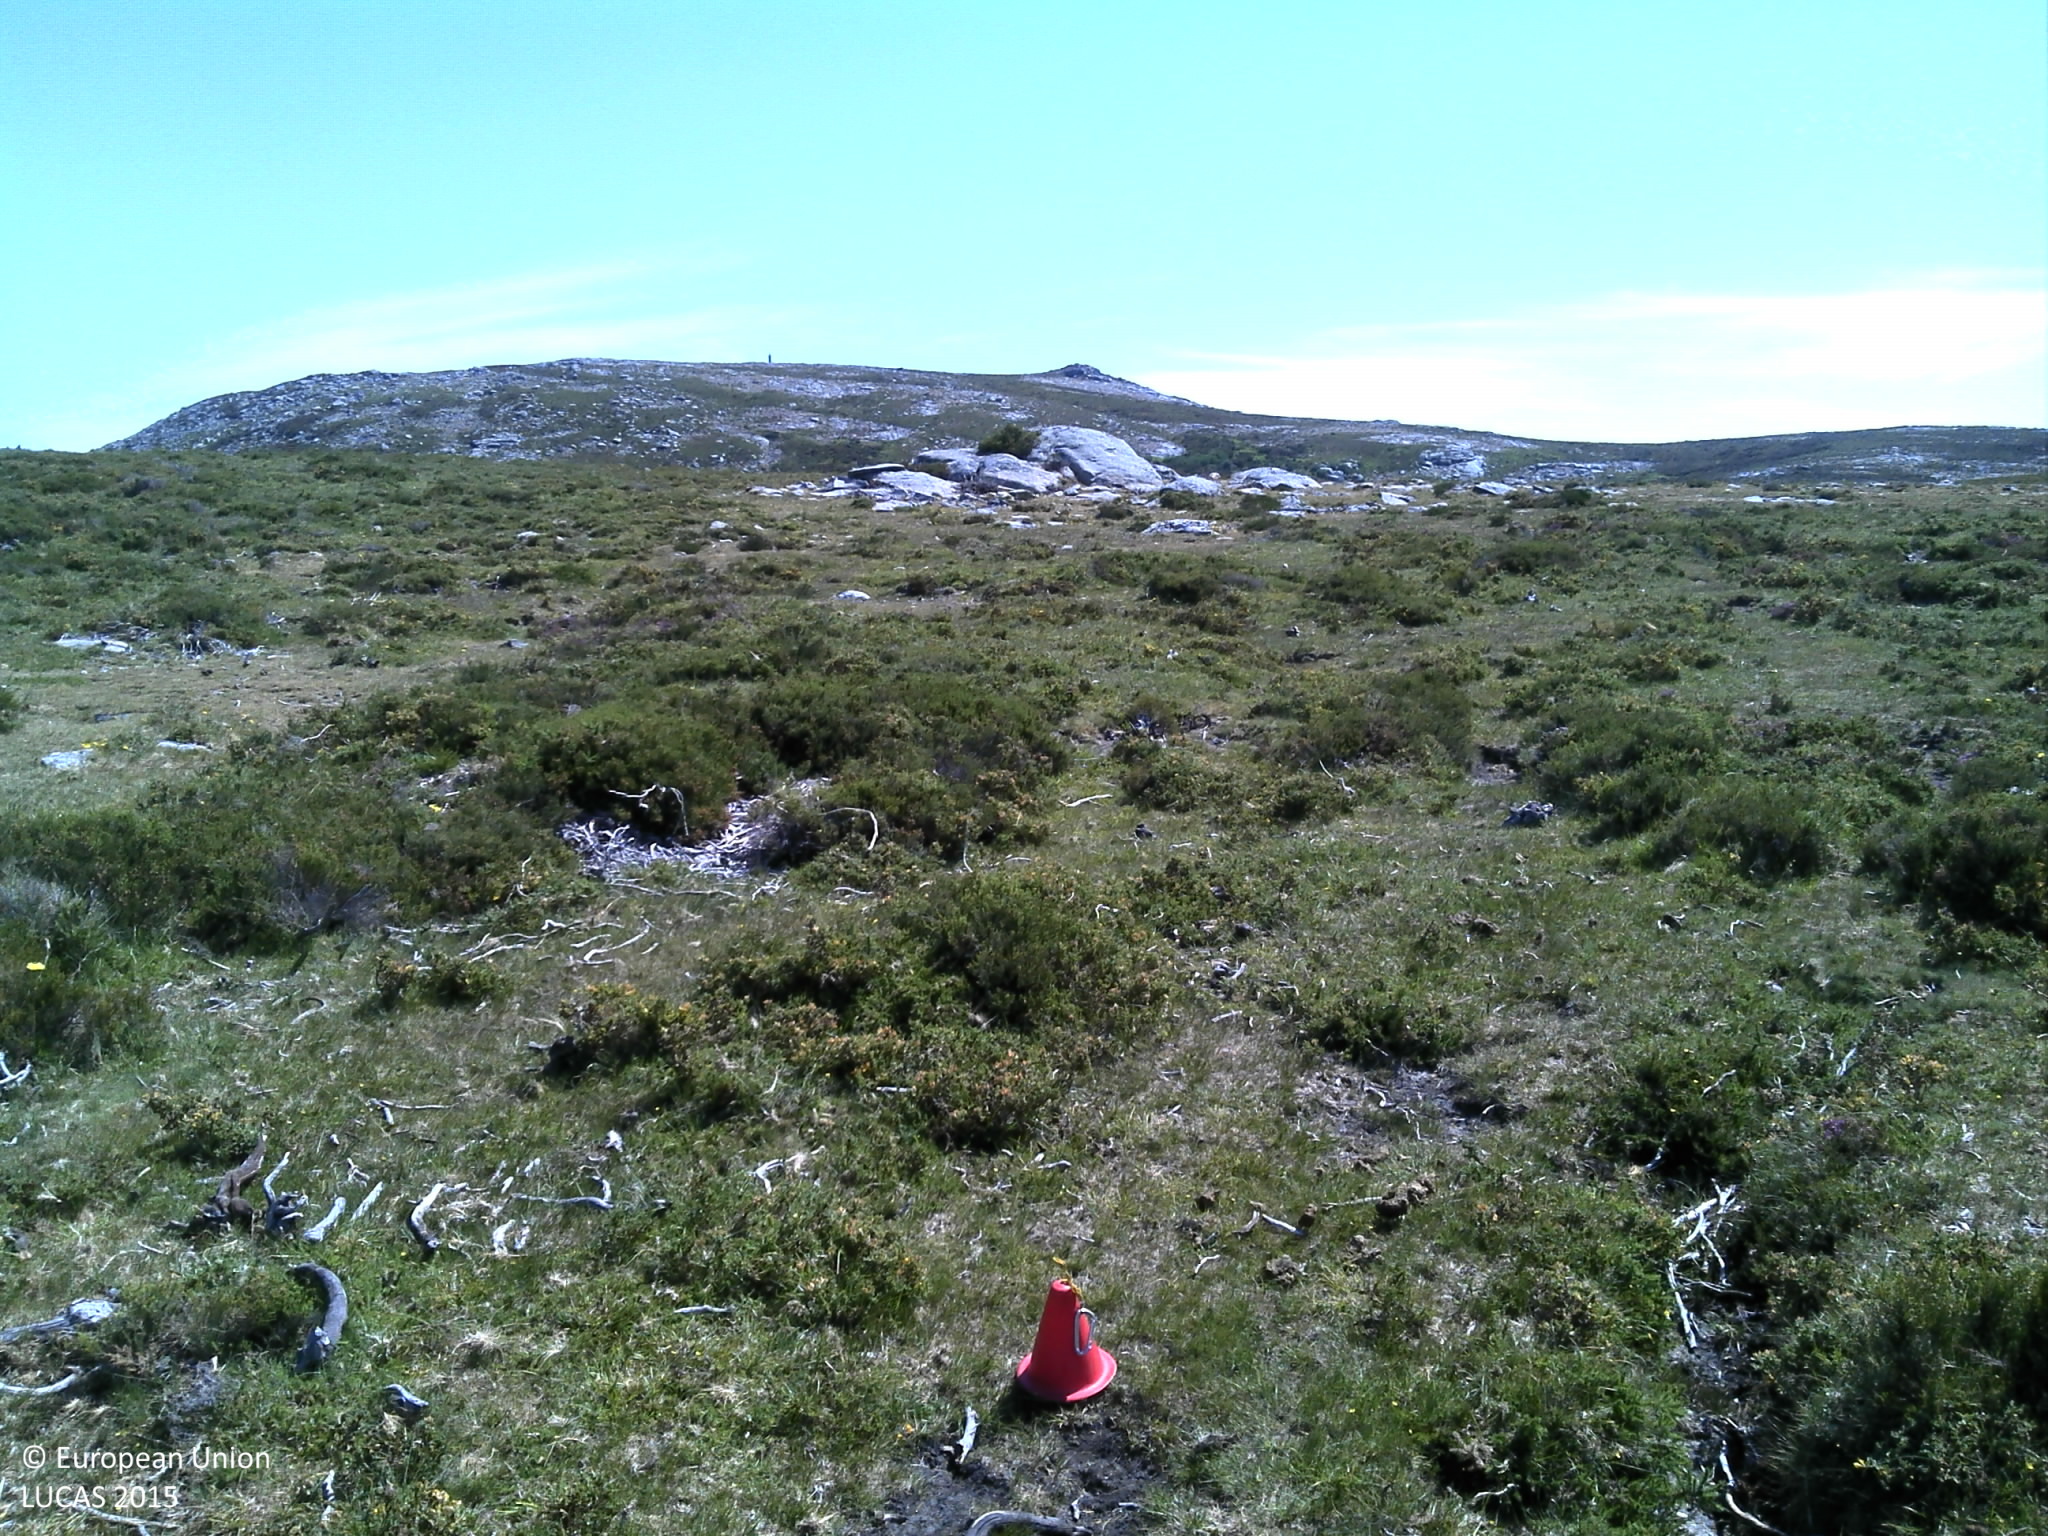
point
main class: Shrubland
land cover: Shrubland without tree cover
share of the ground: 50 - 75 %
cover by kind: shrubs 70 %, herbaceous plants 20 %, consolidated bare surface 5 %, unconsolidated bare surface 5 %
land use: Agriculture (excluding fallow land and kitchen gardens)
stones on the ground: < 10 %
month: June
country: PT
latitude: 41.9642
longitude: -8.3167
